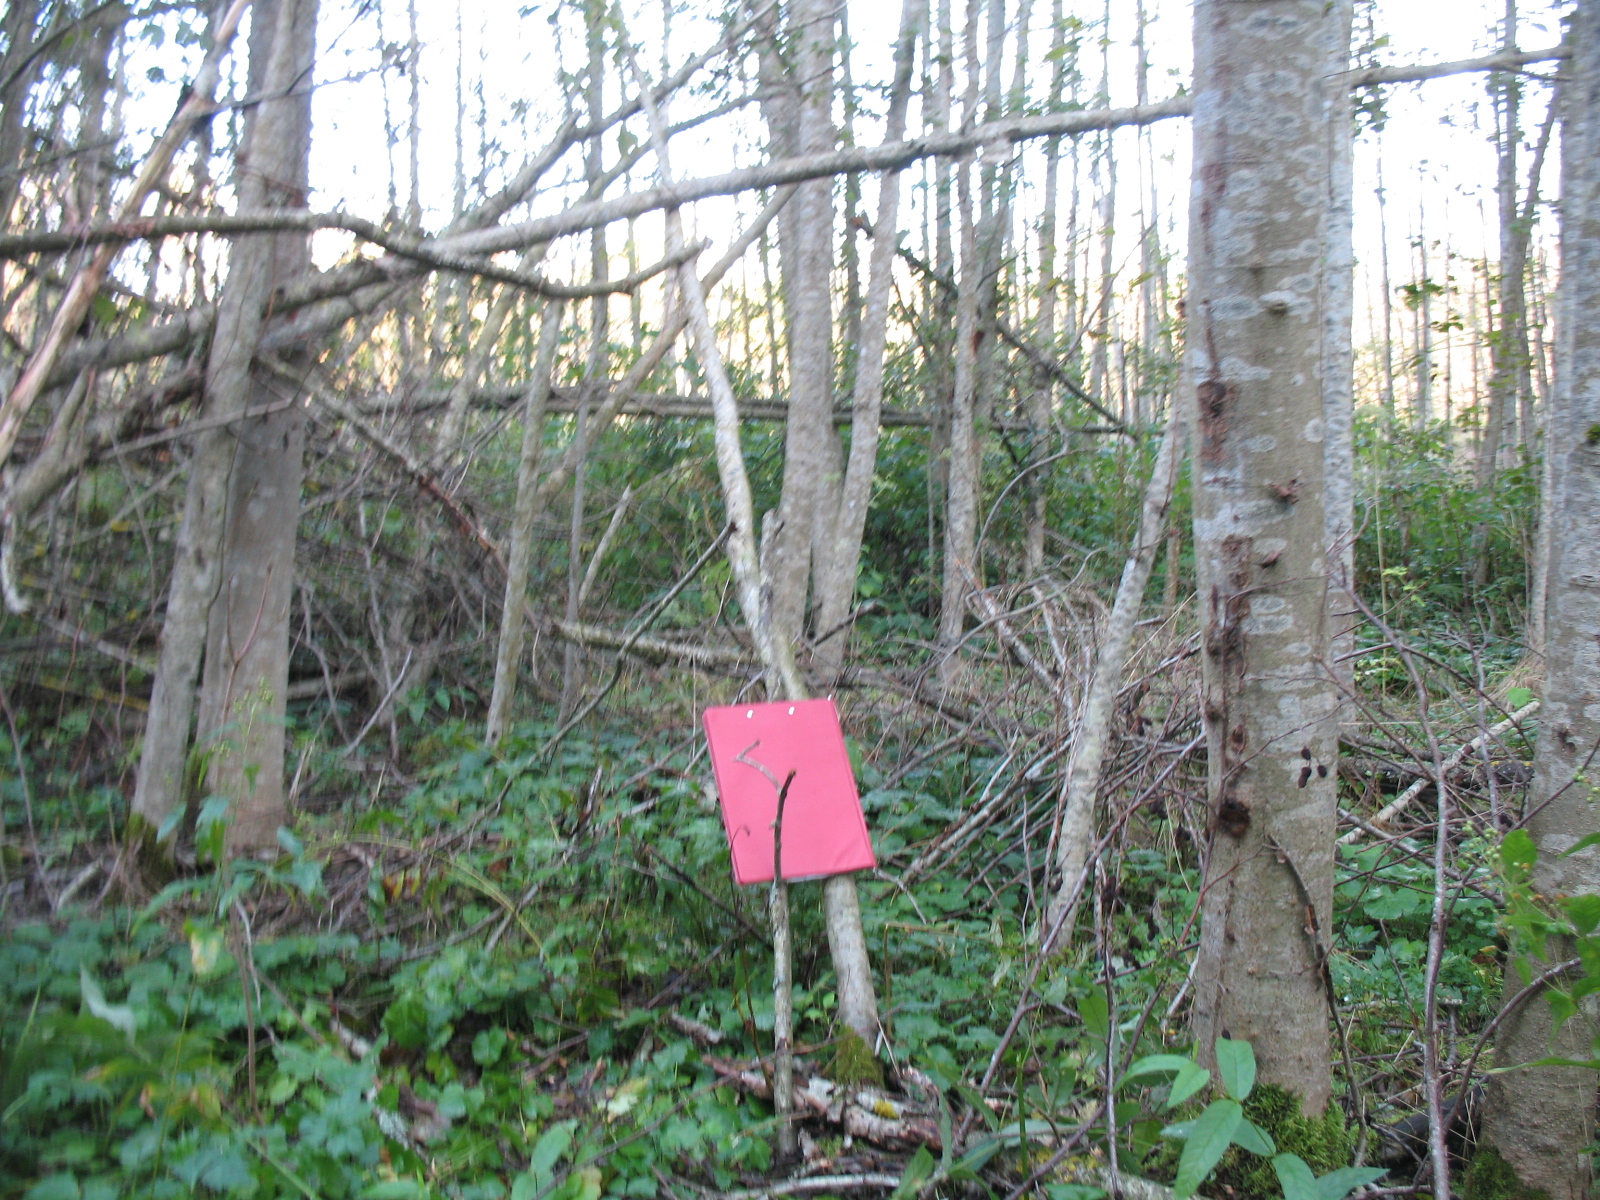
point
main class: Woodland
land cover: Broadleaved woodland
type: floodplain forest
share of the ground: > 75 %
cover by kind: broadleaved forest trees 80 %, herbaceous plants 10 %, lichens and mosses 5 %
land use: Forestry
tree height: > 5 m
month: September
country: LV
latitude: 56.1611
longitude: 25.8959
